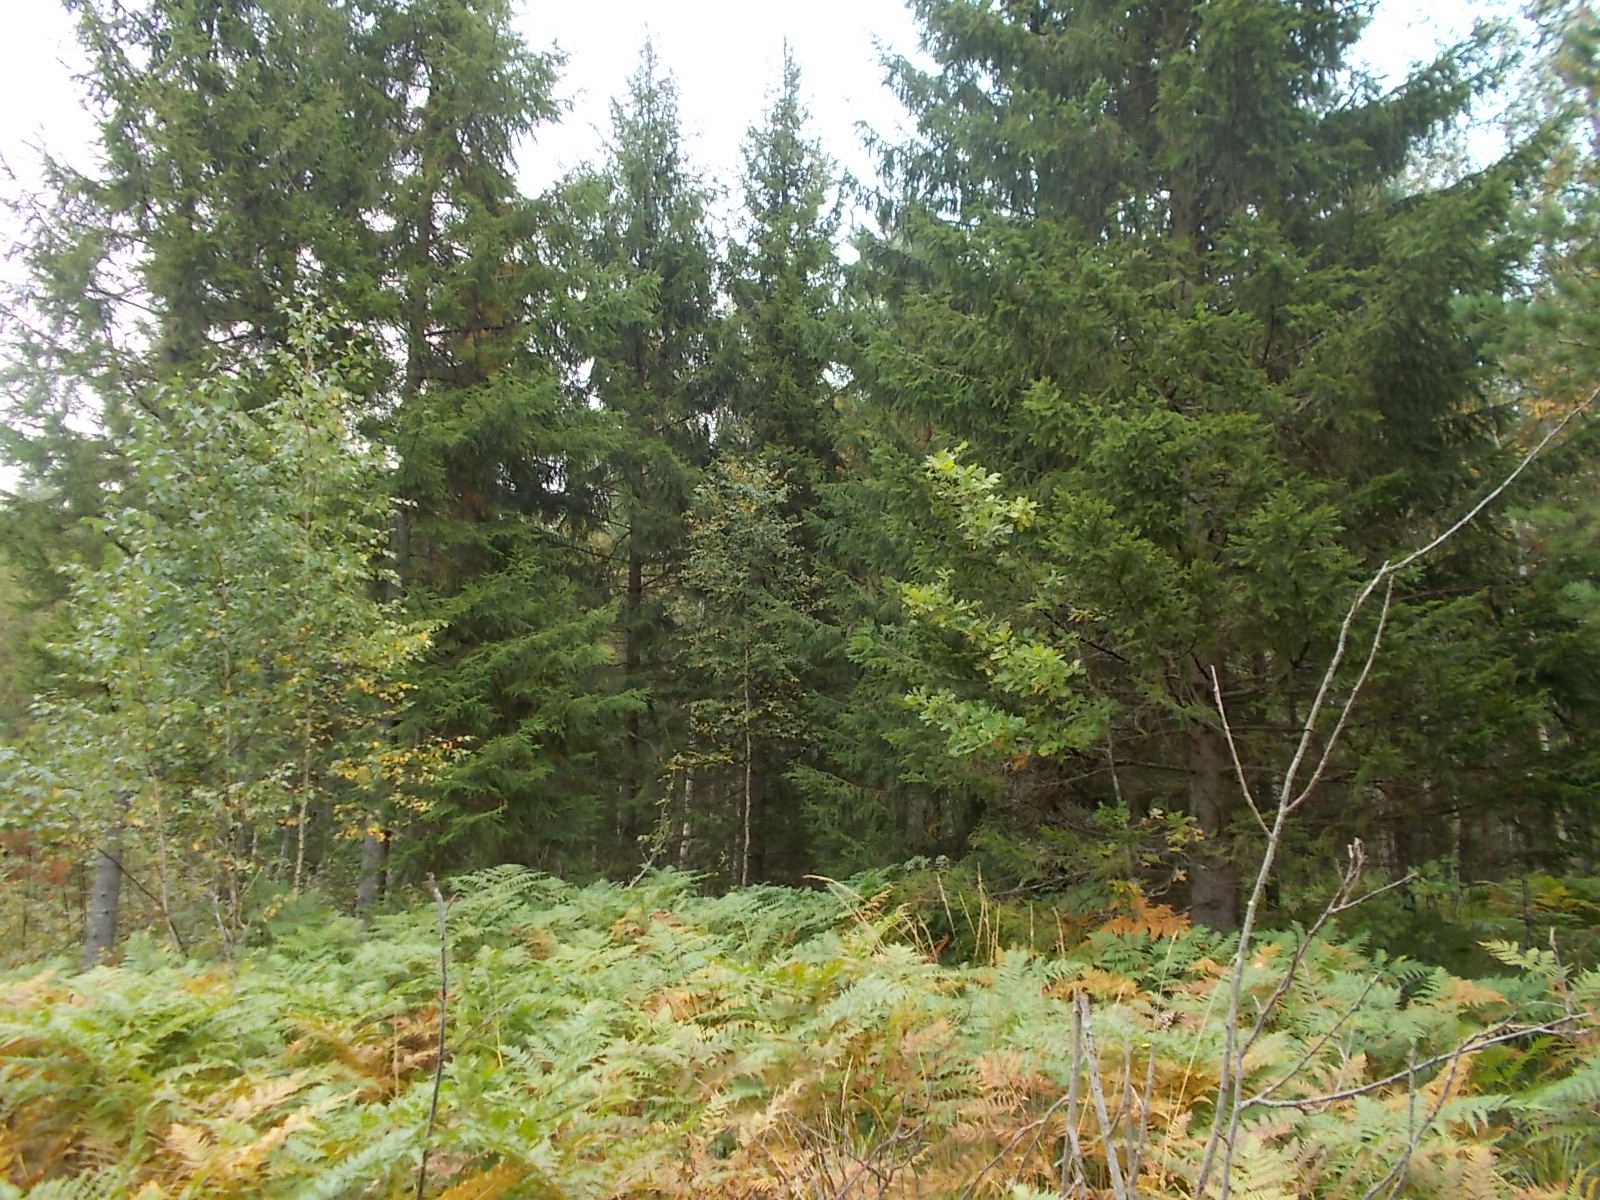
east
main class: Woodland
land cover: Other mixed woodland
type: hemiboreal forest and nemoral coniferous forest and mixed broadleaved-coniferous forest
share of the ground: 50 - 75 %
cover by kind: coniferous forest trees 30 %, broadleaved forest trees 30 %, herbaceous plants 30 %, shrubs 10 %
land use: Forestry
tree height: > 5 m
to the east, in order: Other mixed woodland; Broadleaved woodland; Pine dominated mixed woodland; Spruce dominated mixed woodland
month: September
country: LV
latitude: 57.1602
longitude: 22.1013
